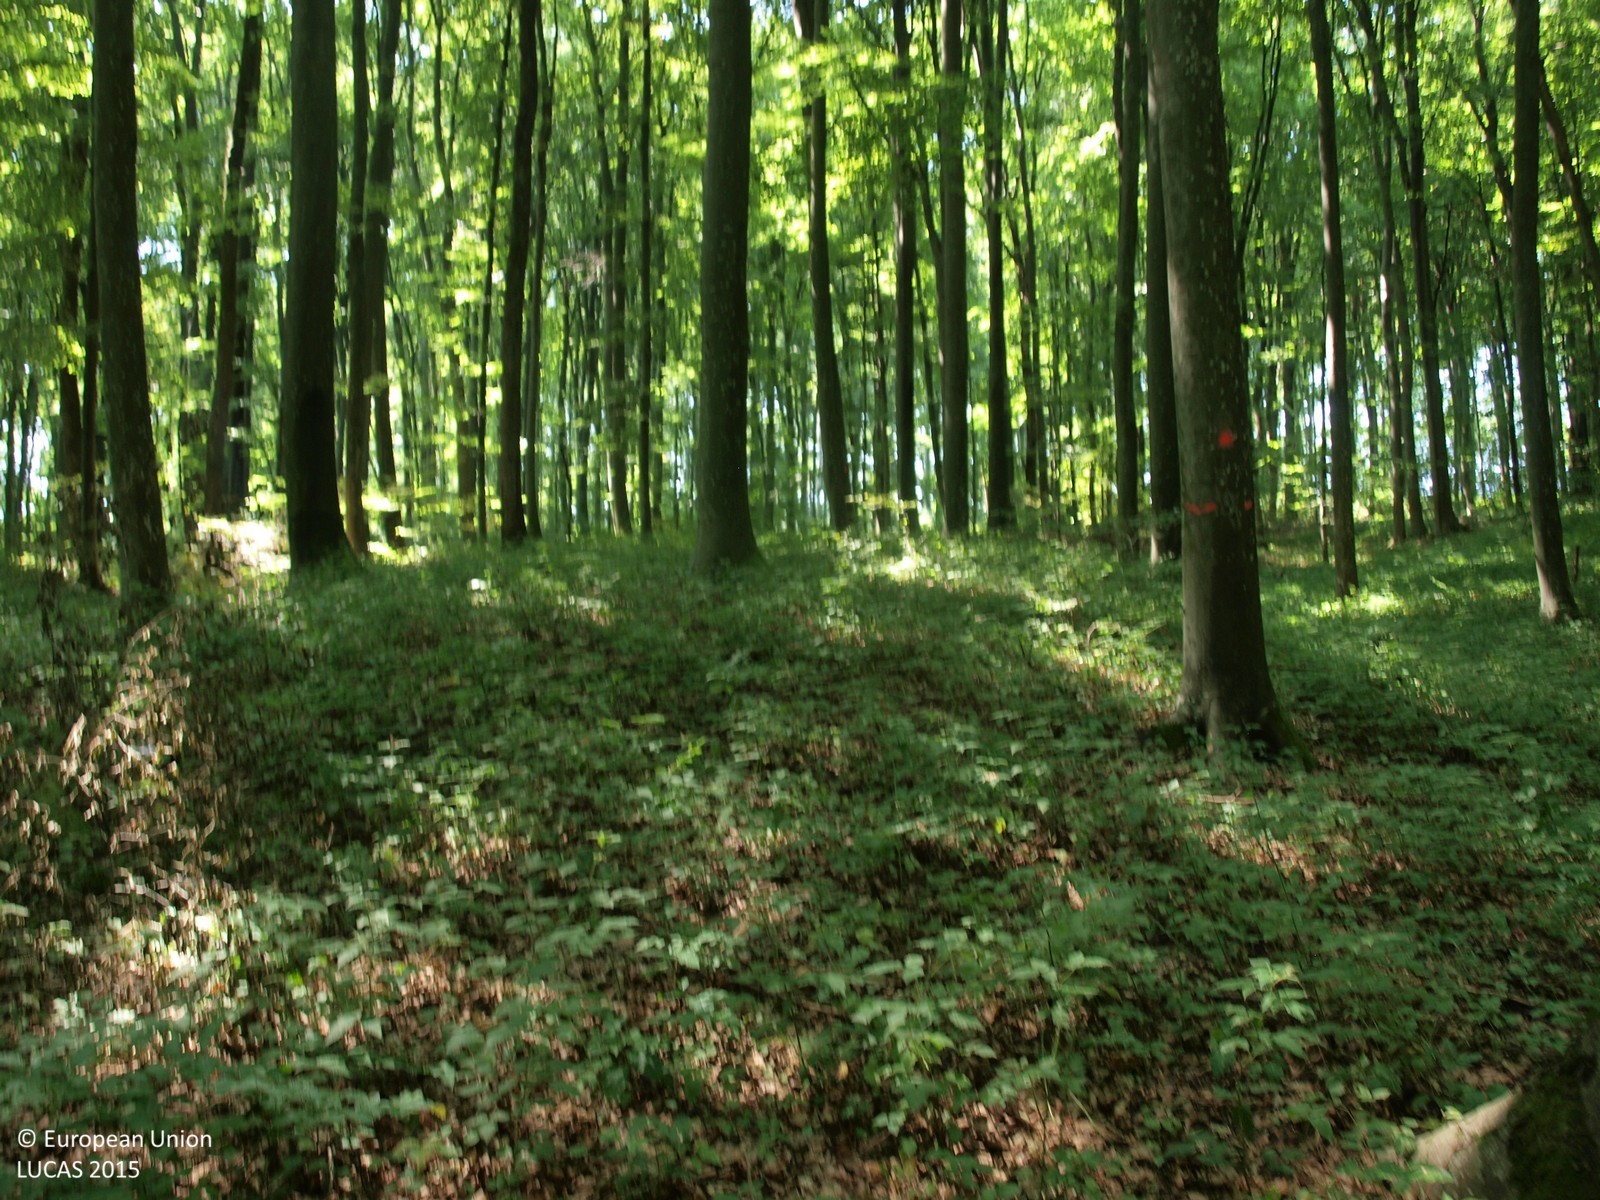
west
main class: Woodland
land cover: Broadleaved woodland
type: beech forest
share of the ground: > 75 %
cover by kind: broadleaved forest trees 100 %
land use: Forestry
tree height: > 5 m
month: August
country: HR
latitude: 45.9654
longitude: 16.6199
